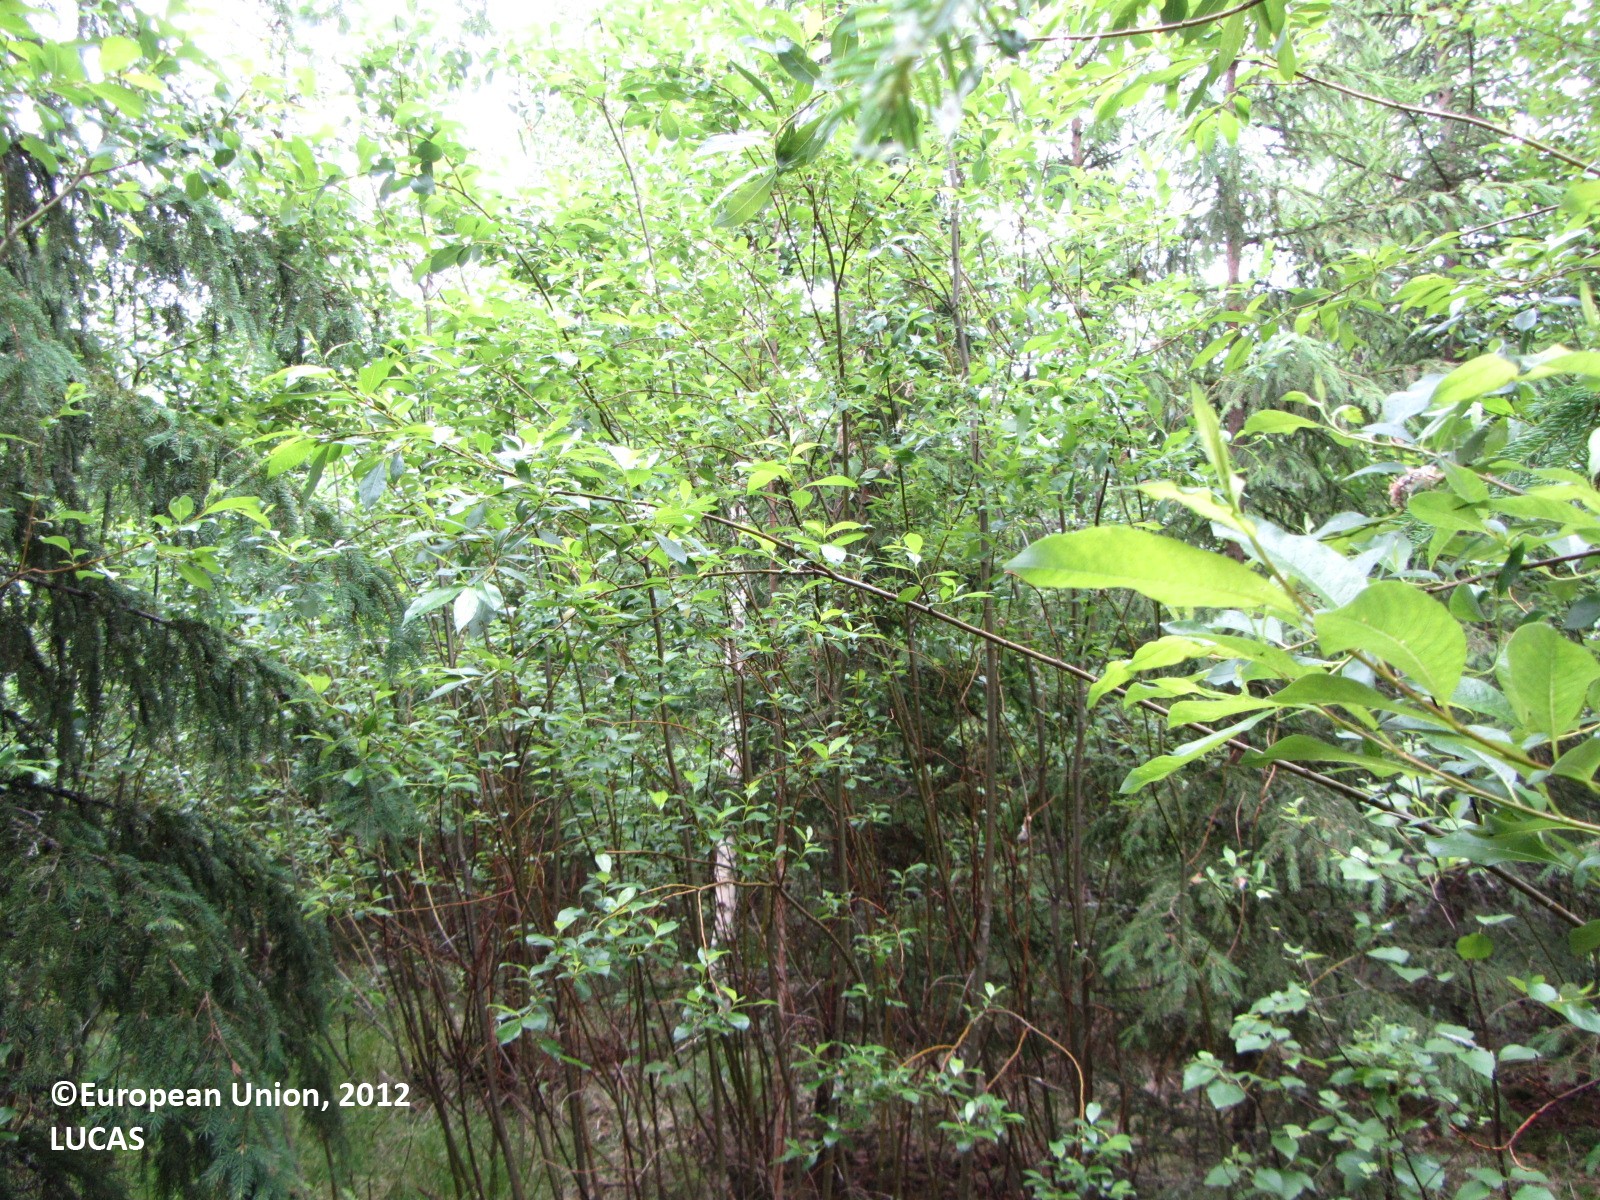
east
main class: Woodland
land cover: Spruce dominated mixed woodland
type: boreal forest
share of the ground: > 75 %
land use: Forestry
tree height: > 5 m
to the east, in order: Spruce dominated mixed woodland; Tracks; Spruce dominated mixed woodland; Ditches and canals; Spruce dominated mixed woodland; Spontaneously vegetated surfaces; Ditches and canals; Grass margins; Paved roads, cycling and walking lanes; Grass margins; Ditches and canals; Spontaneously vegetated surfaces; Other leguminous and mixtures for fodder
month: June
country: FI
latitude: 62.6211
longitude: 25.6090
